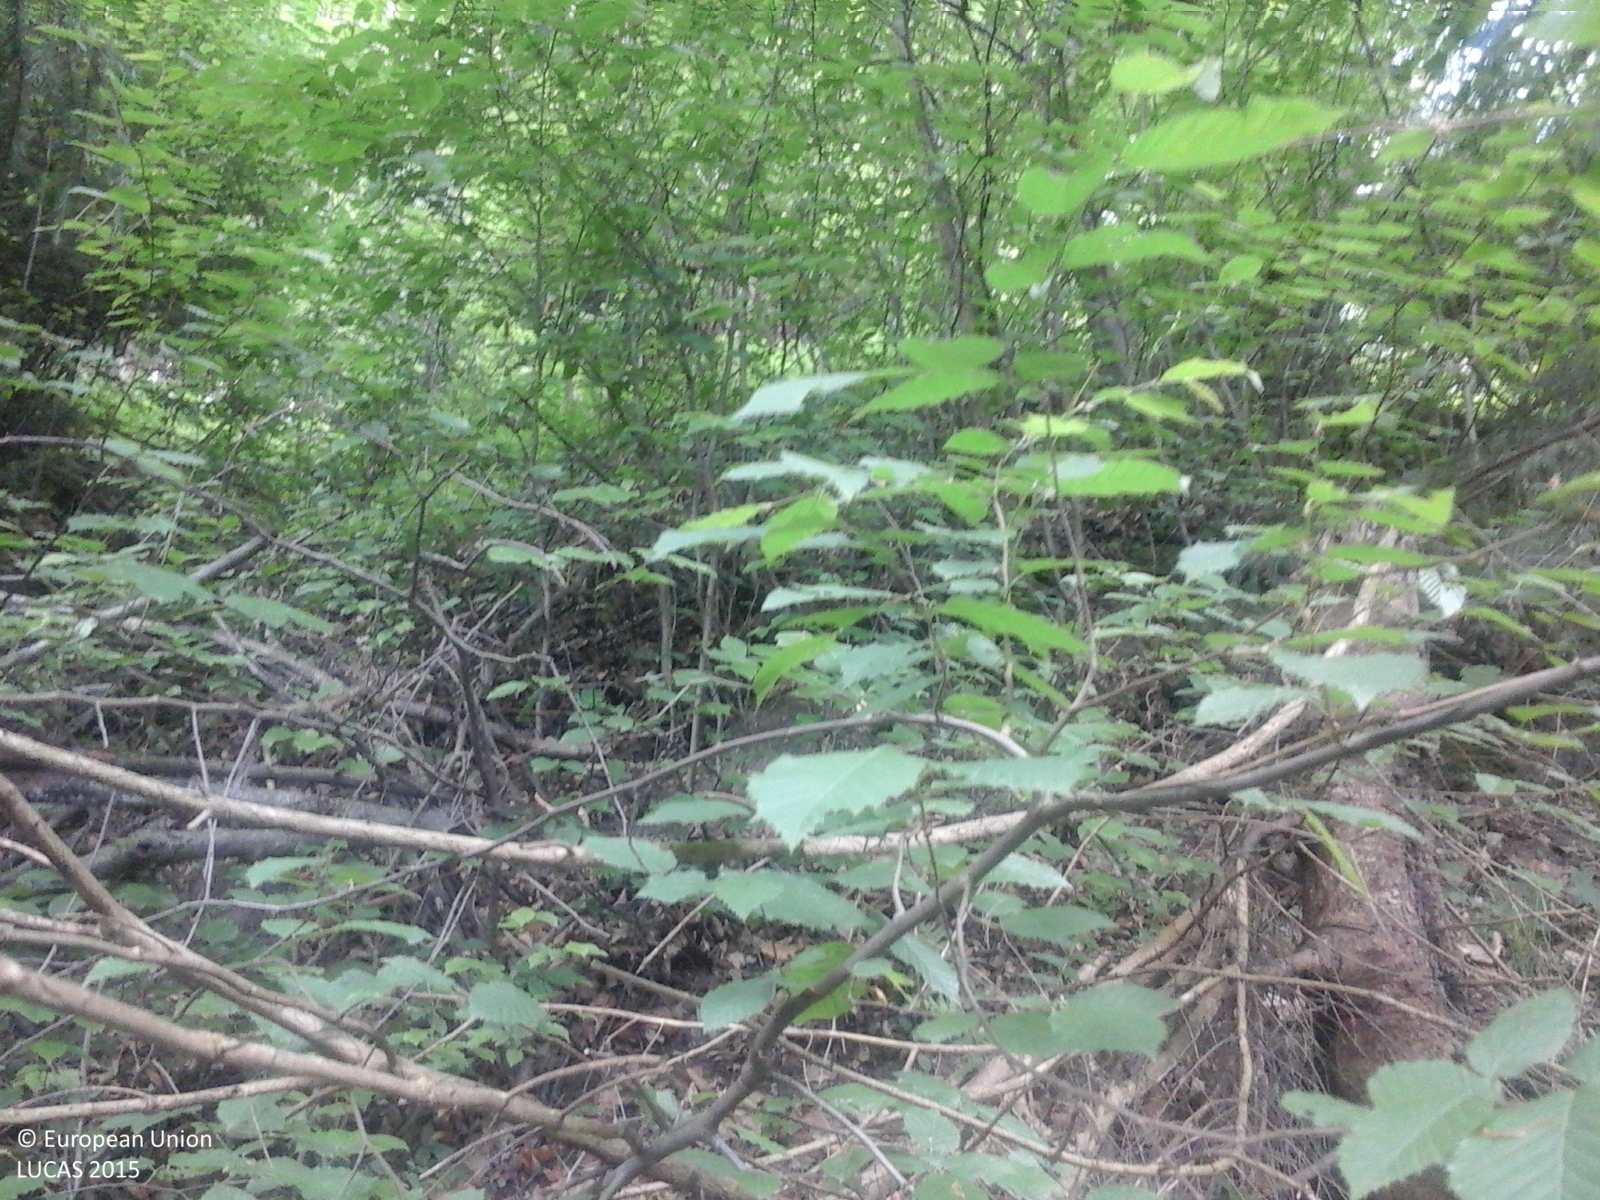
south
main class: Woodland
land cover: Other mixed woodland
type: alpine coniferous forest
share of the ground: > 75 %
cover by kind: coniferous forest trees 70 %, broadleaved forest trees 30 %
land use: Forestry
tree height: > 5 m
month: June
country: RO
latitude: 46.5309
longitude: 26.3626
